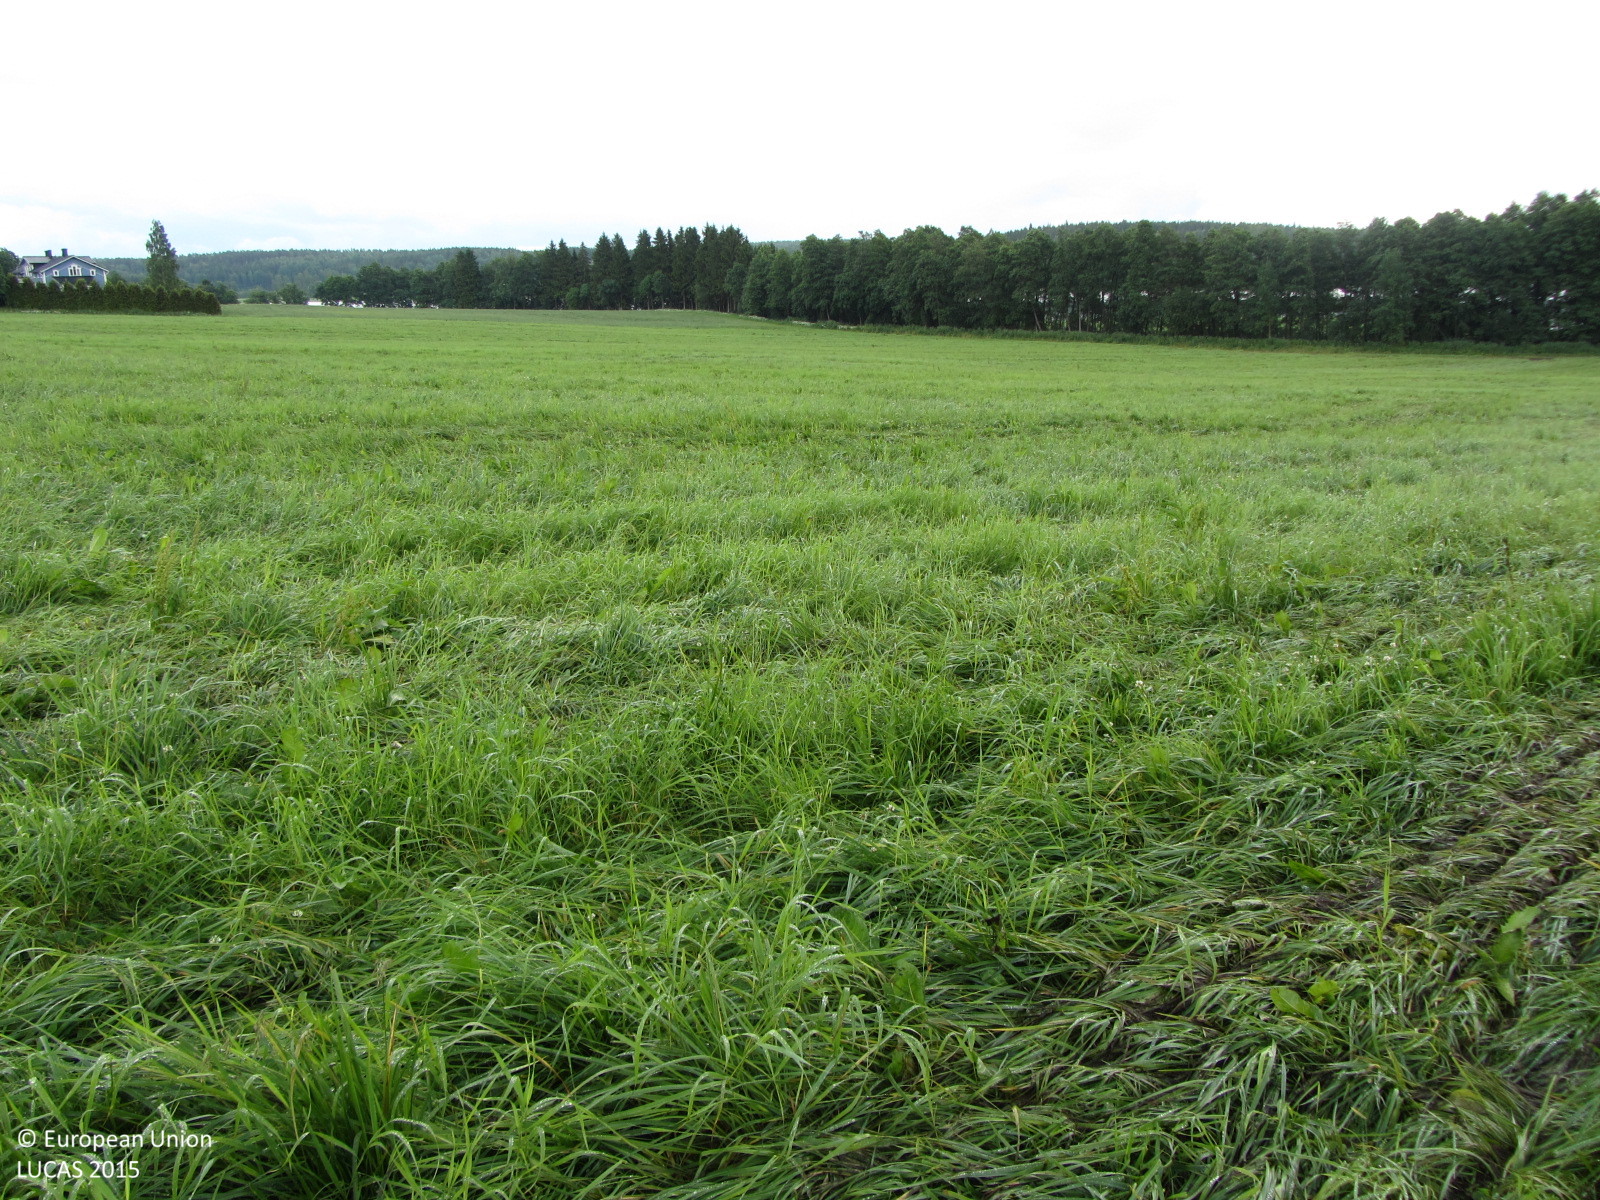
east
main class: Grassland
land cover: Grassland without tree/shrub cover
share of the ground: > 75 %
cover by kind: herbaceous plants 100 %
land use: Agriculture (excluding fallow land and kitchen gardens)
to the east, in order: Grassland without tree/shrub cover
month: July
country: FI
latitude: 60.0495
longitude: 23.2111
